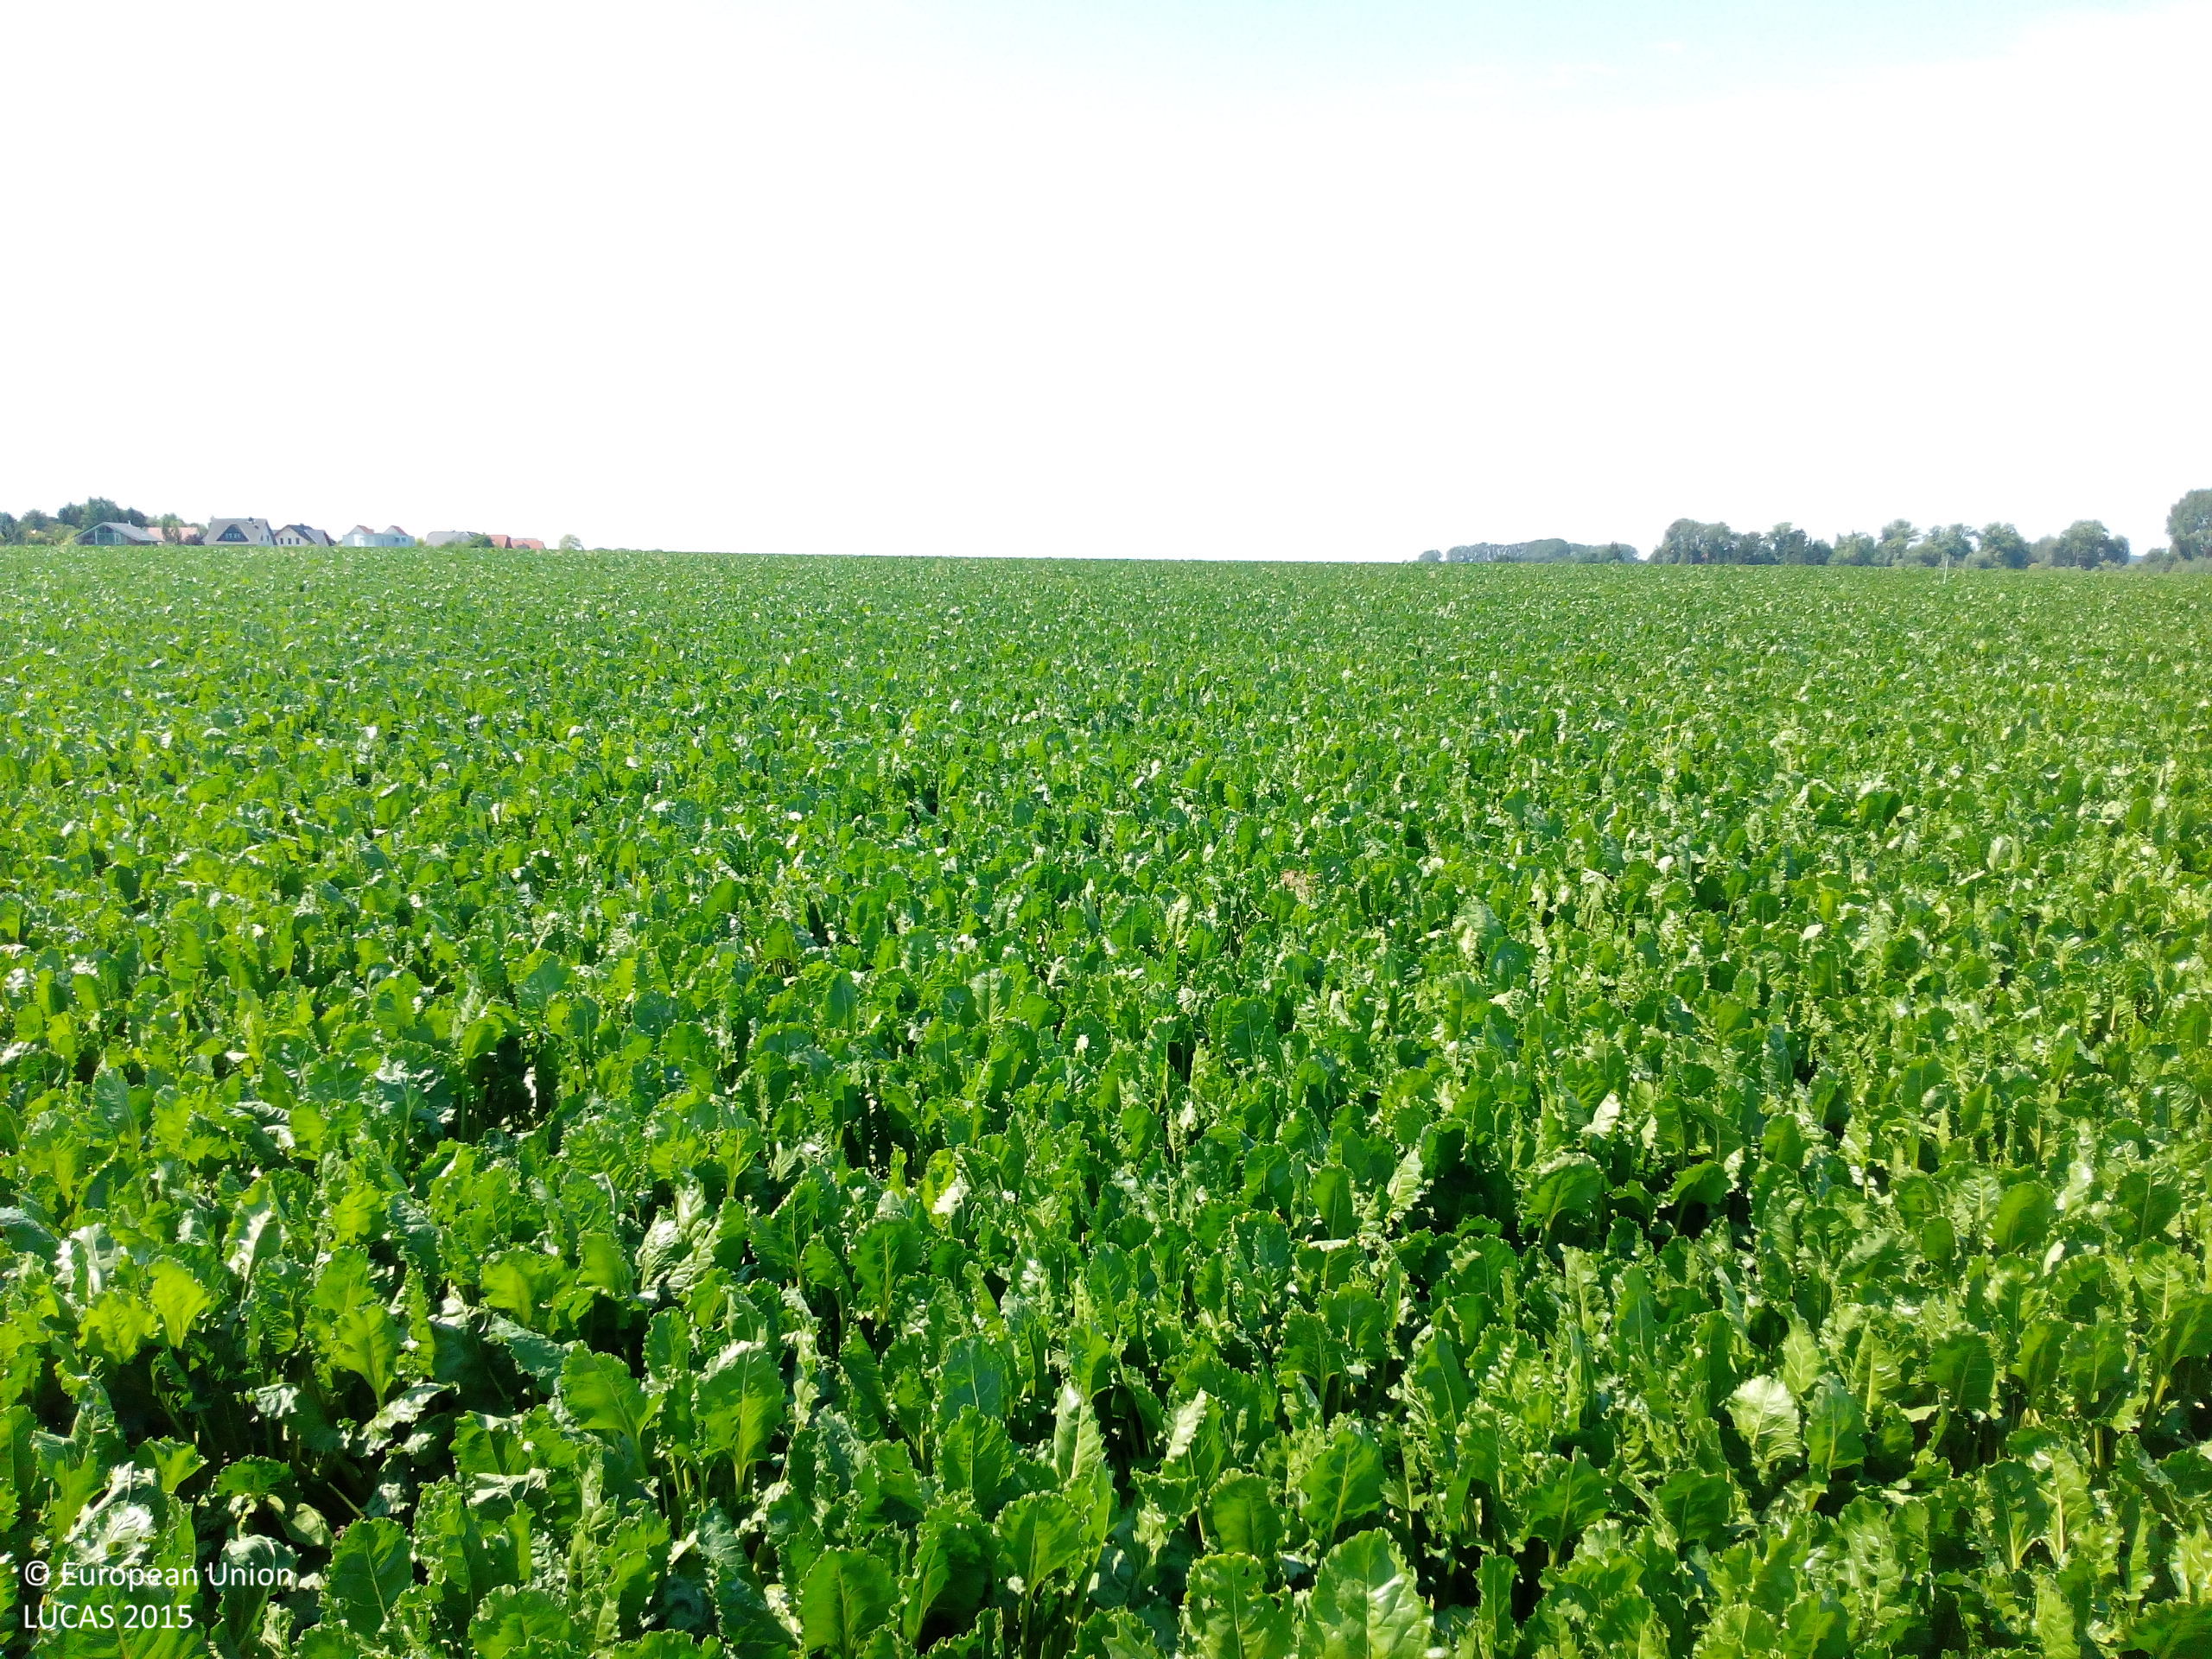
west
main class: Cropland
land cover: Sugar beet
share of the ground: > 75 %
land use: Agriculture (excluding fallow land and kitchen gardens)
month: August
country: DE
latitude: 52.1960
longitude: 10.6289
